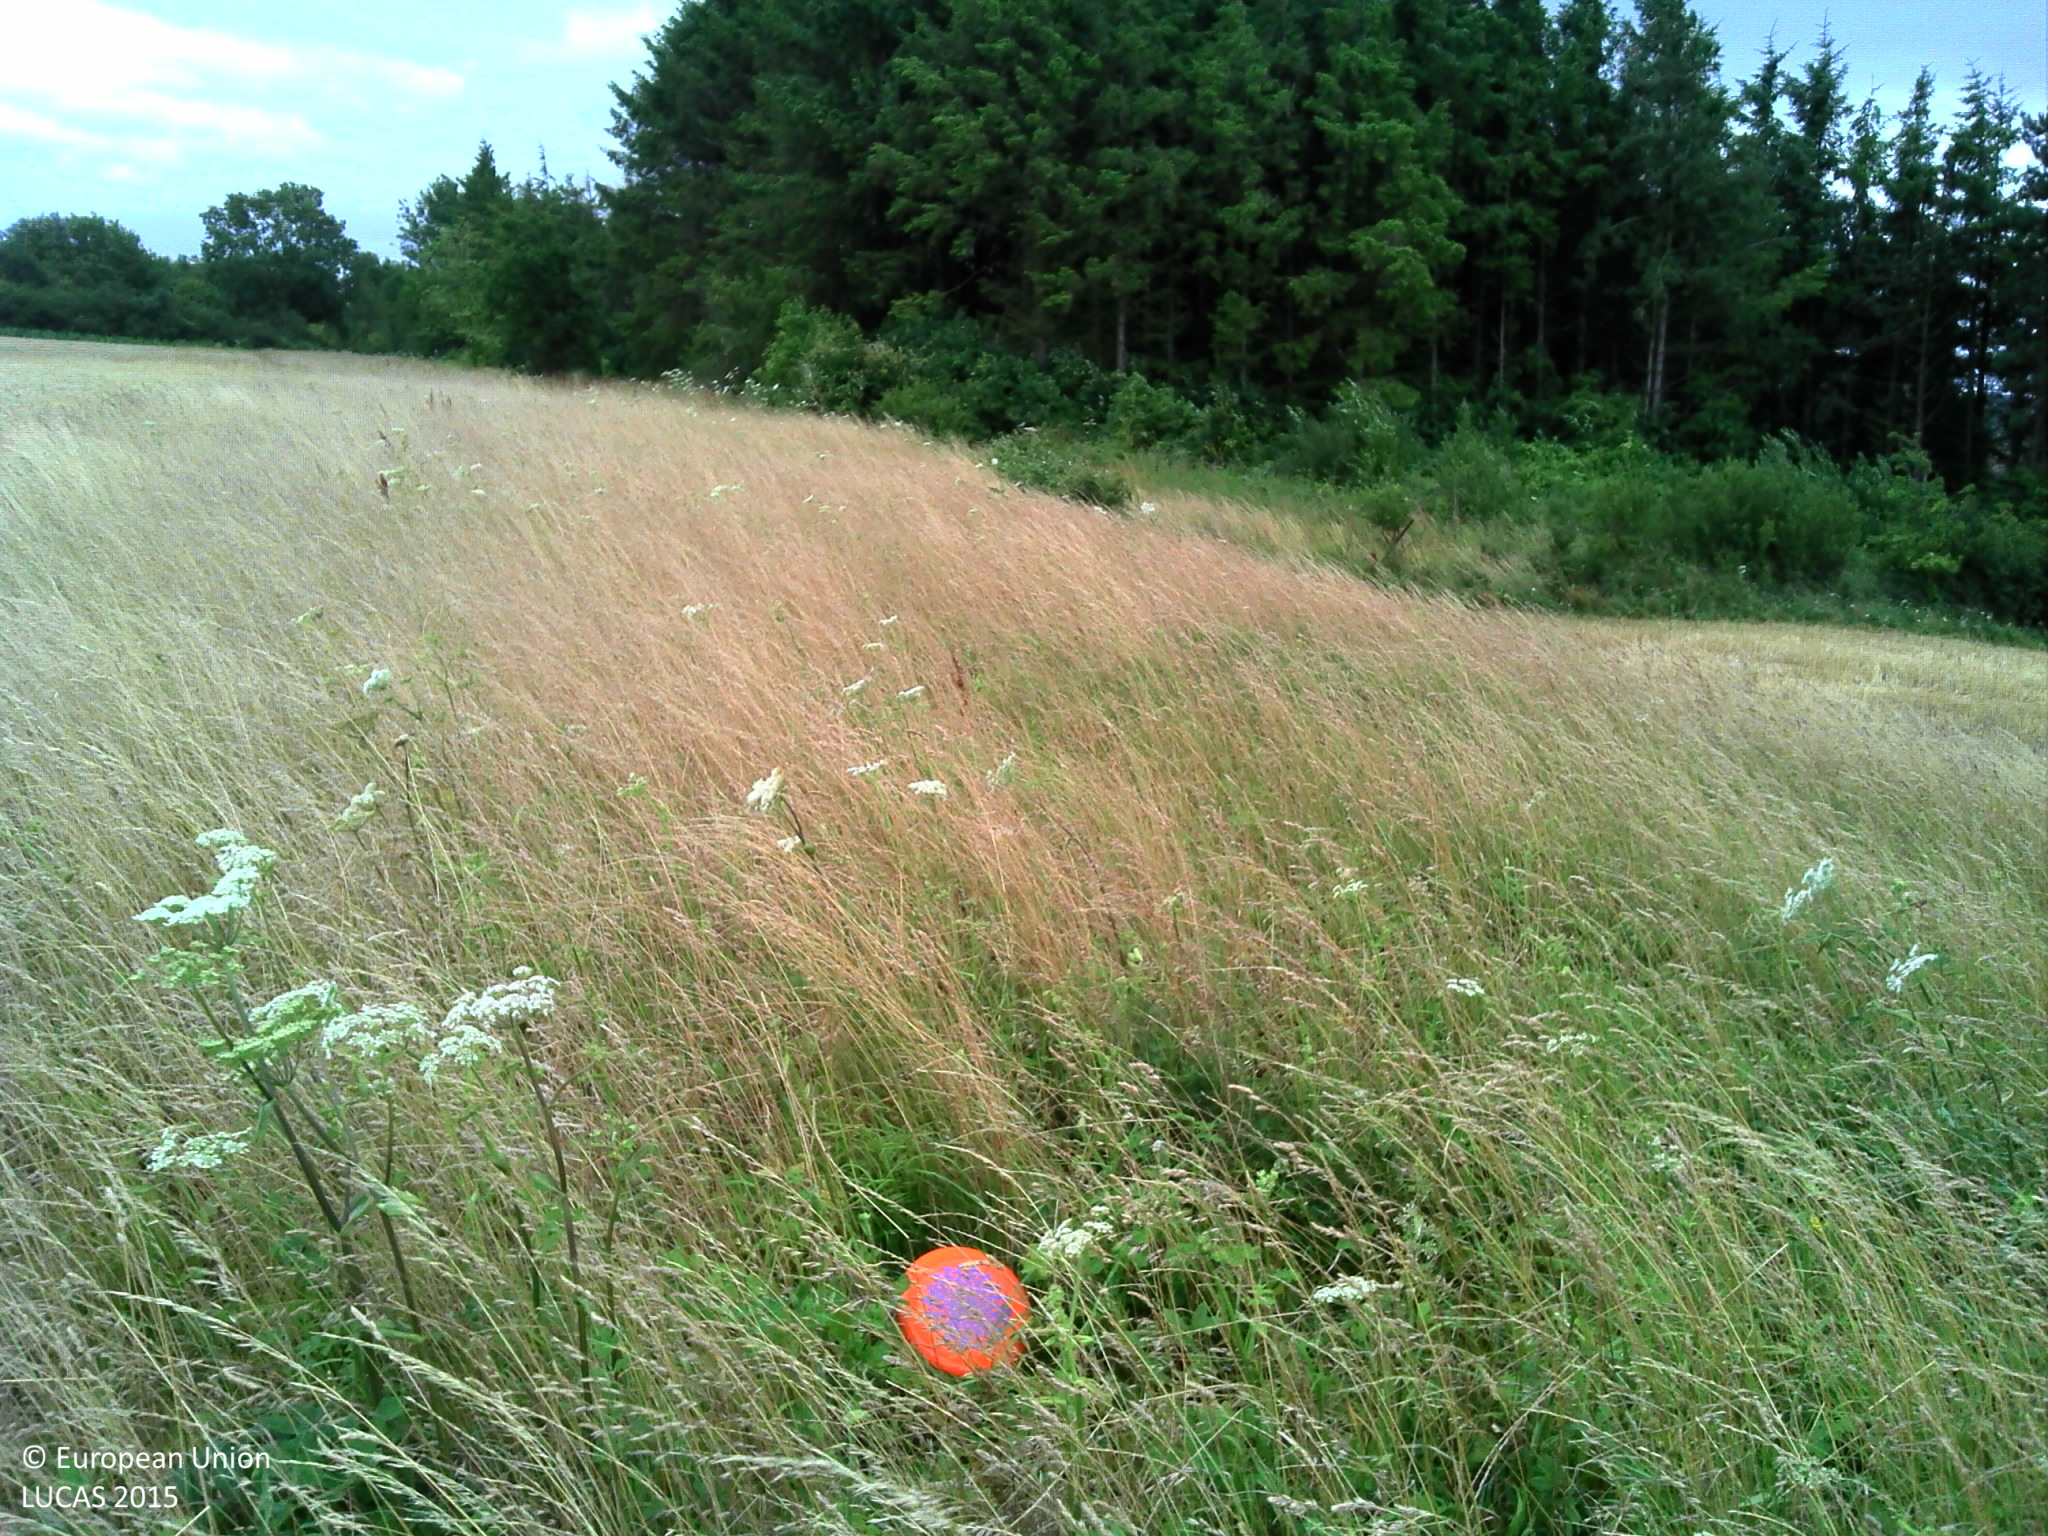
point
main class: Grassland
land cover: Grassland without tree/shrub cover
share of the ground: > 75 %
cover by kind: herbaceous plants 60 %
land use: Agriculture (excluding fallow land and kitchen gardens)
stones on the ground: 10 - 25 %
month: July
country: FR
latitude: 50.7385
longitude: 2.0636
